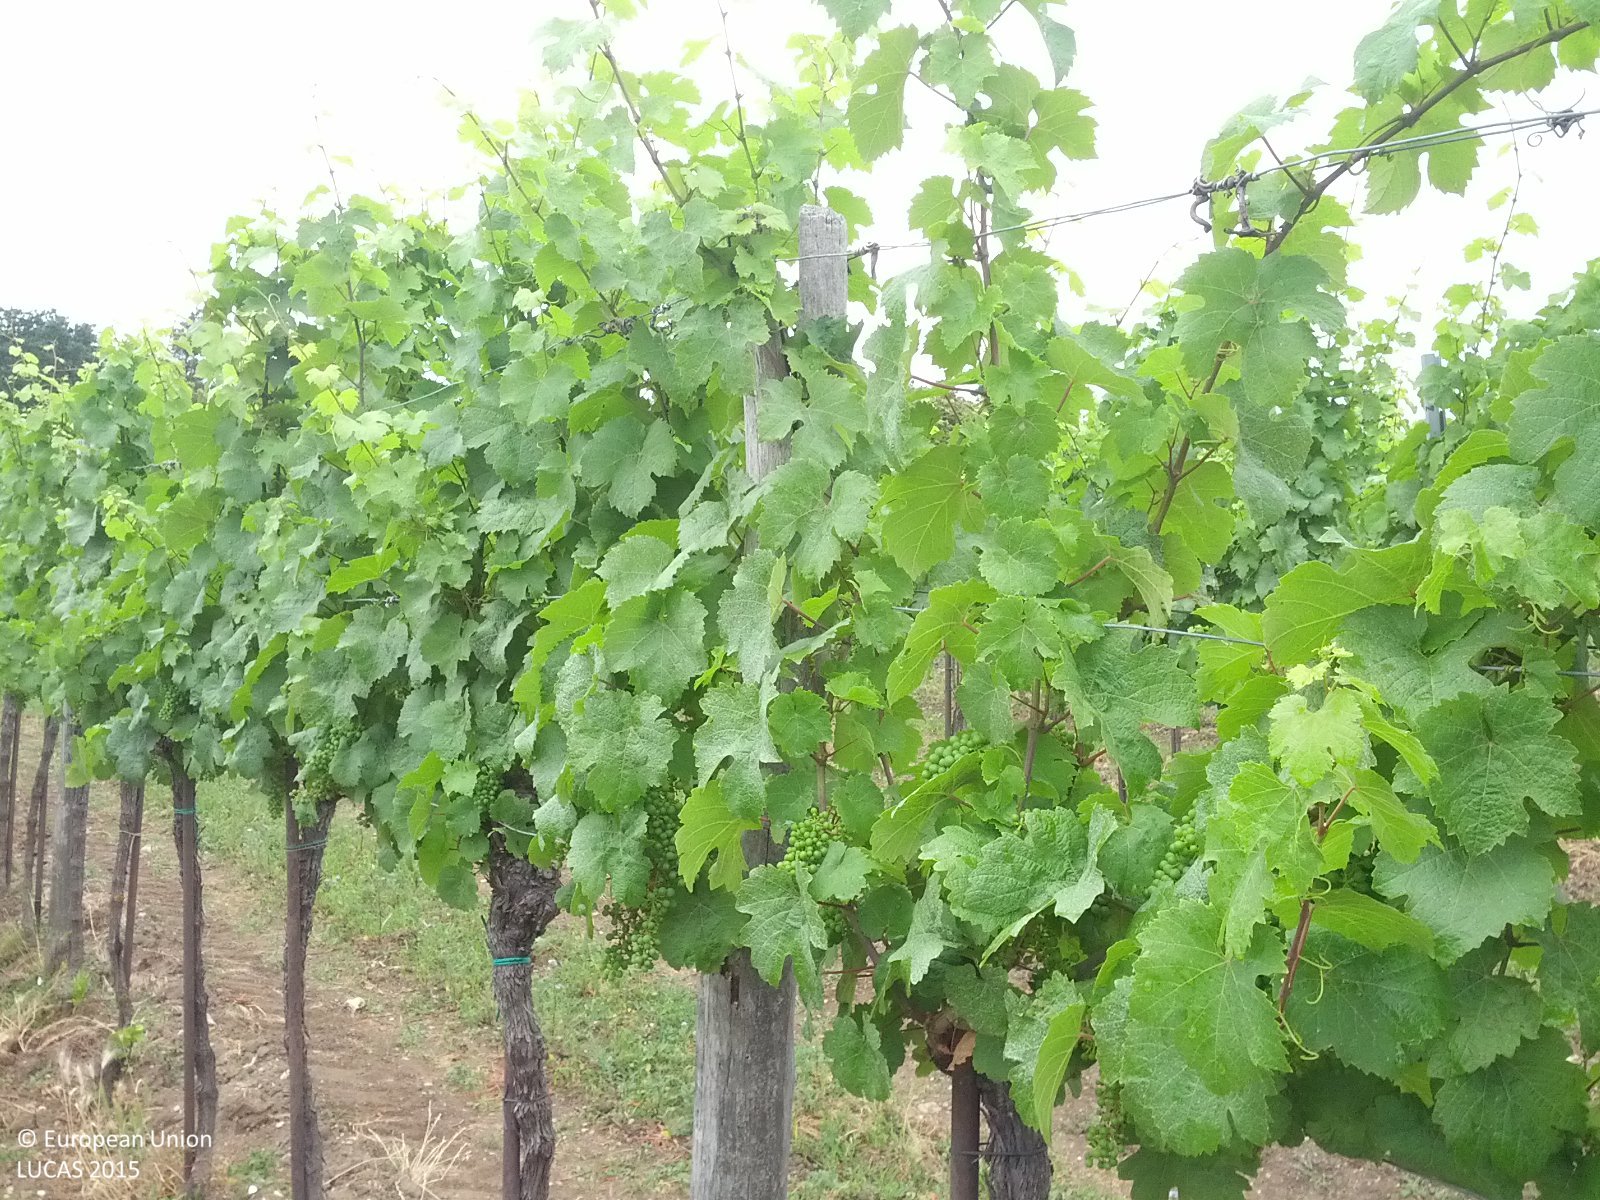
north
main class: Cropland
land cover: Vineyards
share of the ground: 25 - 50 %
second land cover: Grassland without tree/shrub cover
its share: 50 - 75 %
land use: Agriculture (excluding fallow land and kitchen gardens)
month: July
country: AT
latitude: 48.7460
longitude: 16.6300
